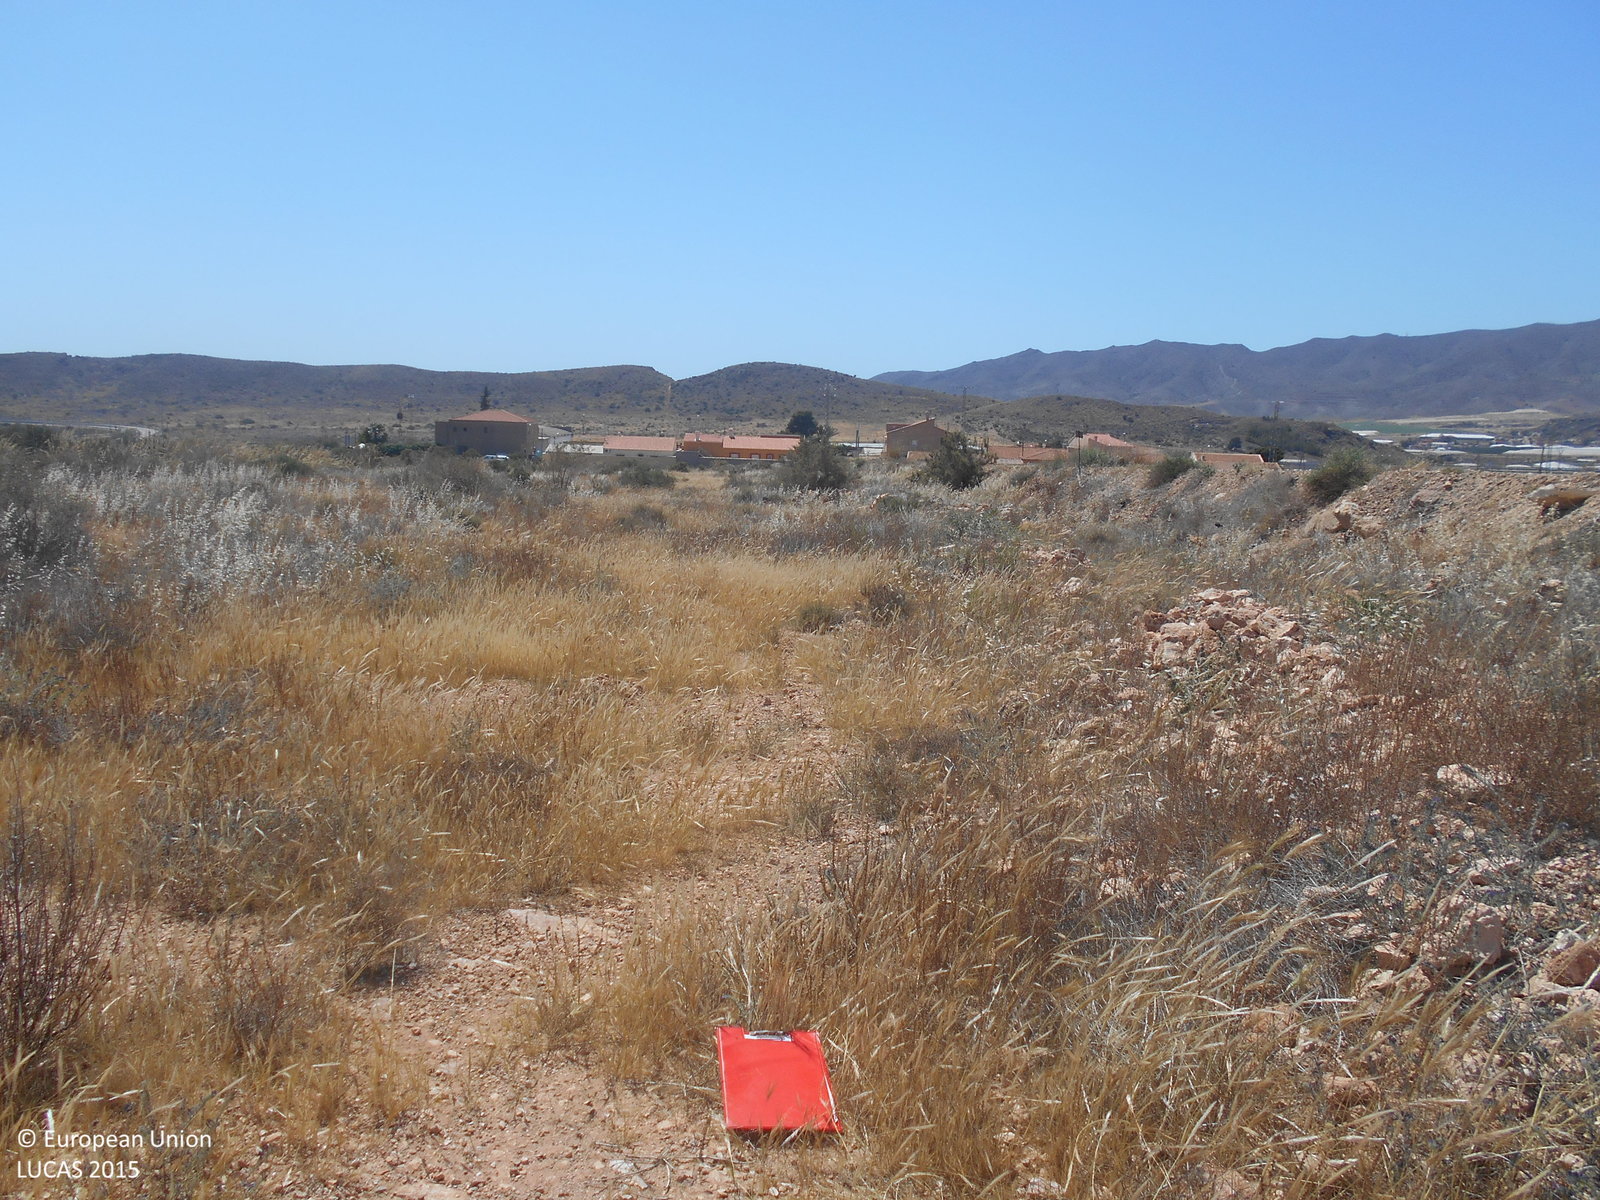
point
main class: Shrubland
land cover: Shrubland without tree cover
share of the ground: 50 - 75 %
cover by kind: herbaceous plants 40 %, shrubs 20 %, consolidated bare surface 20 %, unconsolidated bare surface 20 %
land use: Semi-natural and natural areas not in use
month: May
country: ES
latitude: 37.5481
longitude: -1.4456
